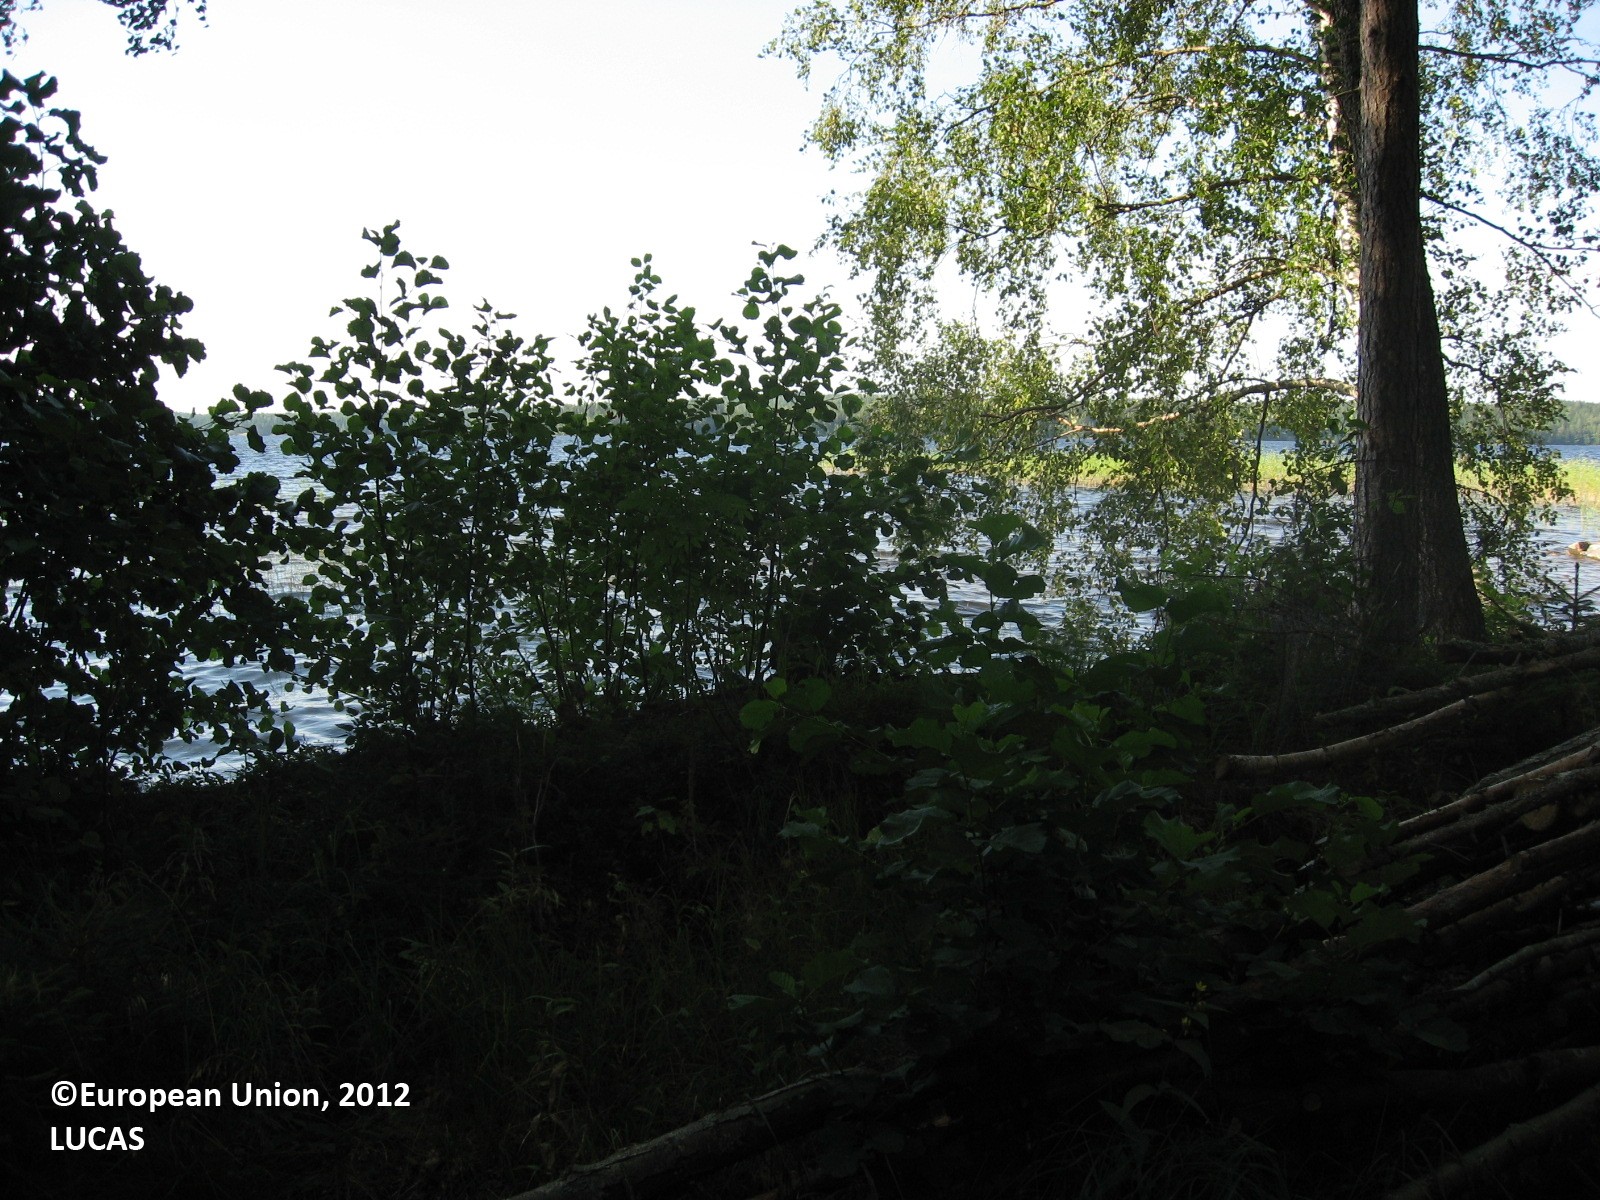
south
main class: Woodland
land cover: Other mixed woodland
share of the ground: 50 - 75 %
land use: Forestry
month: August
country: FI
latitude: 61.4368
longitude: 25.9764
